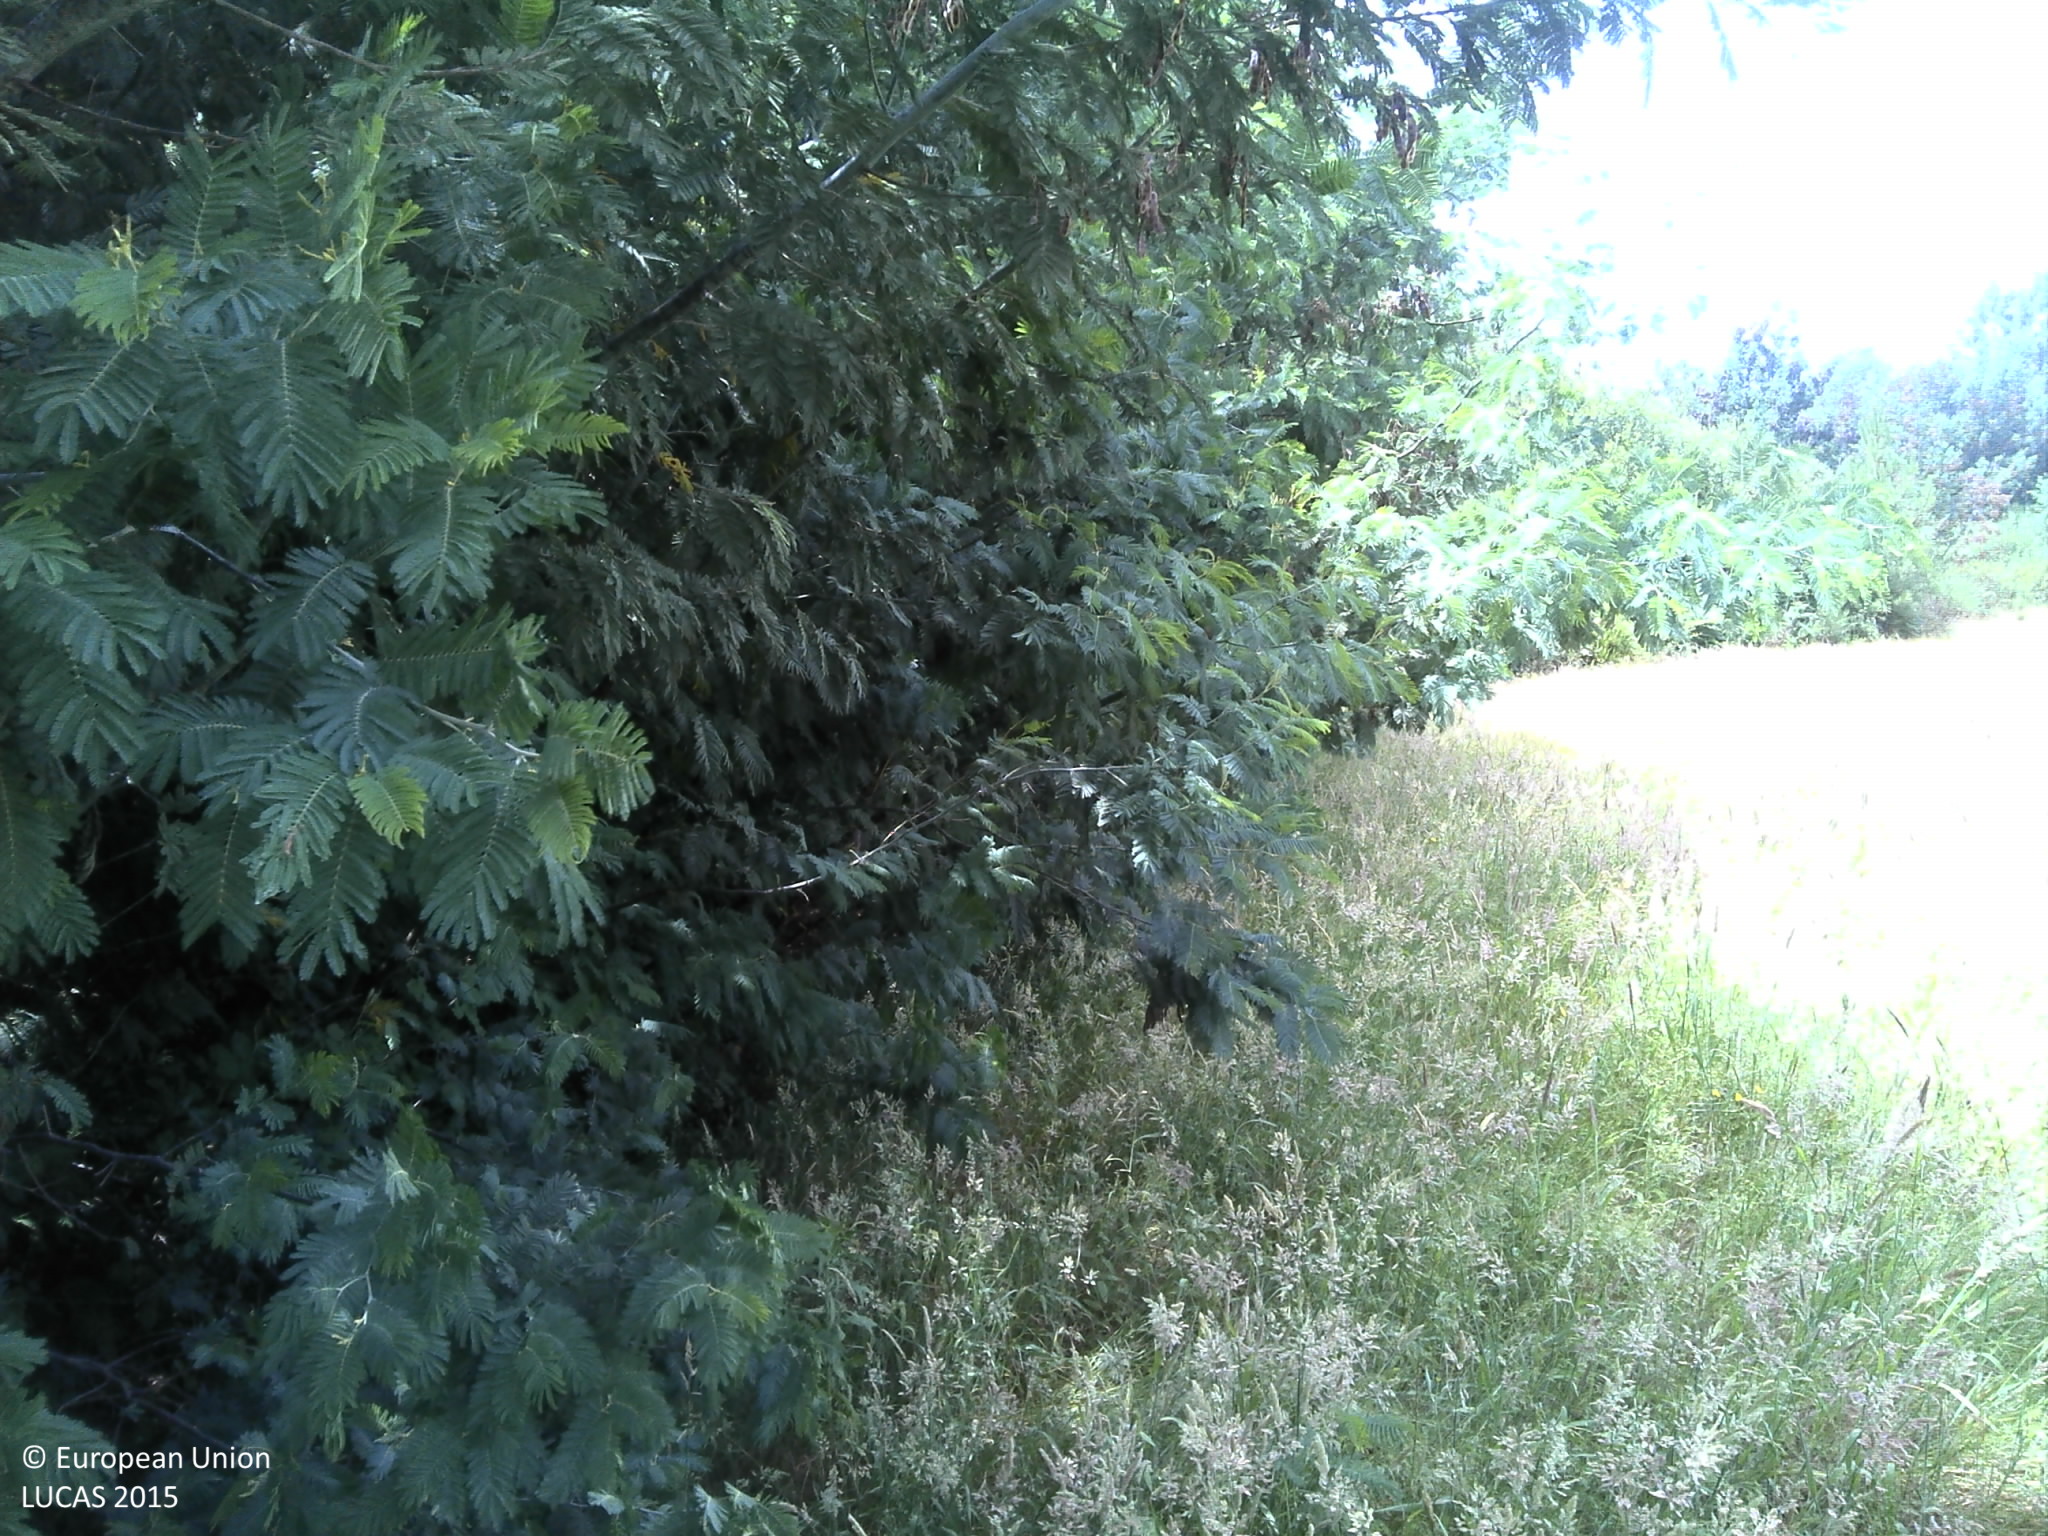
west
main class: Woodland
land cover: Broadleaved woodland
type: exotic forest
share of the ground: > 75 %
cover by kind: broadleaved forest trees 85 %, unconsolidated bare surface 10 %, shrubs 5 %
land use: Forestry
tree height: > 5 m
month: June
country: PT
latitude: 40.1482
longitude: -7.3453
